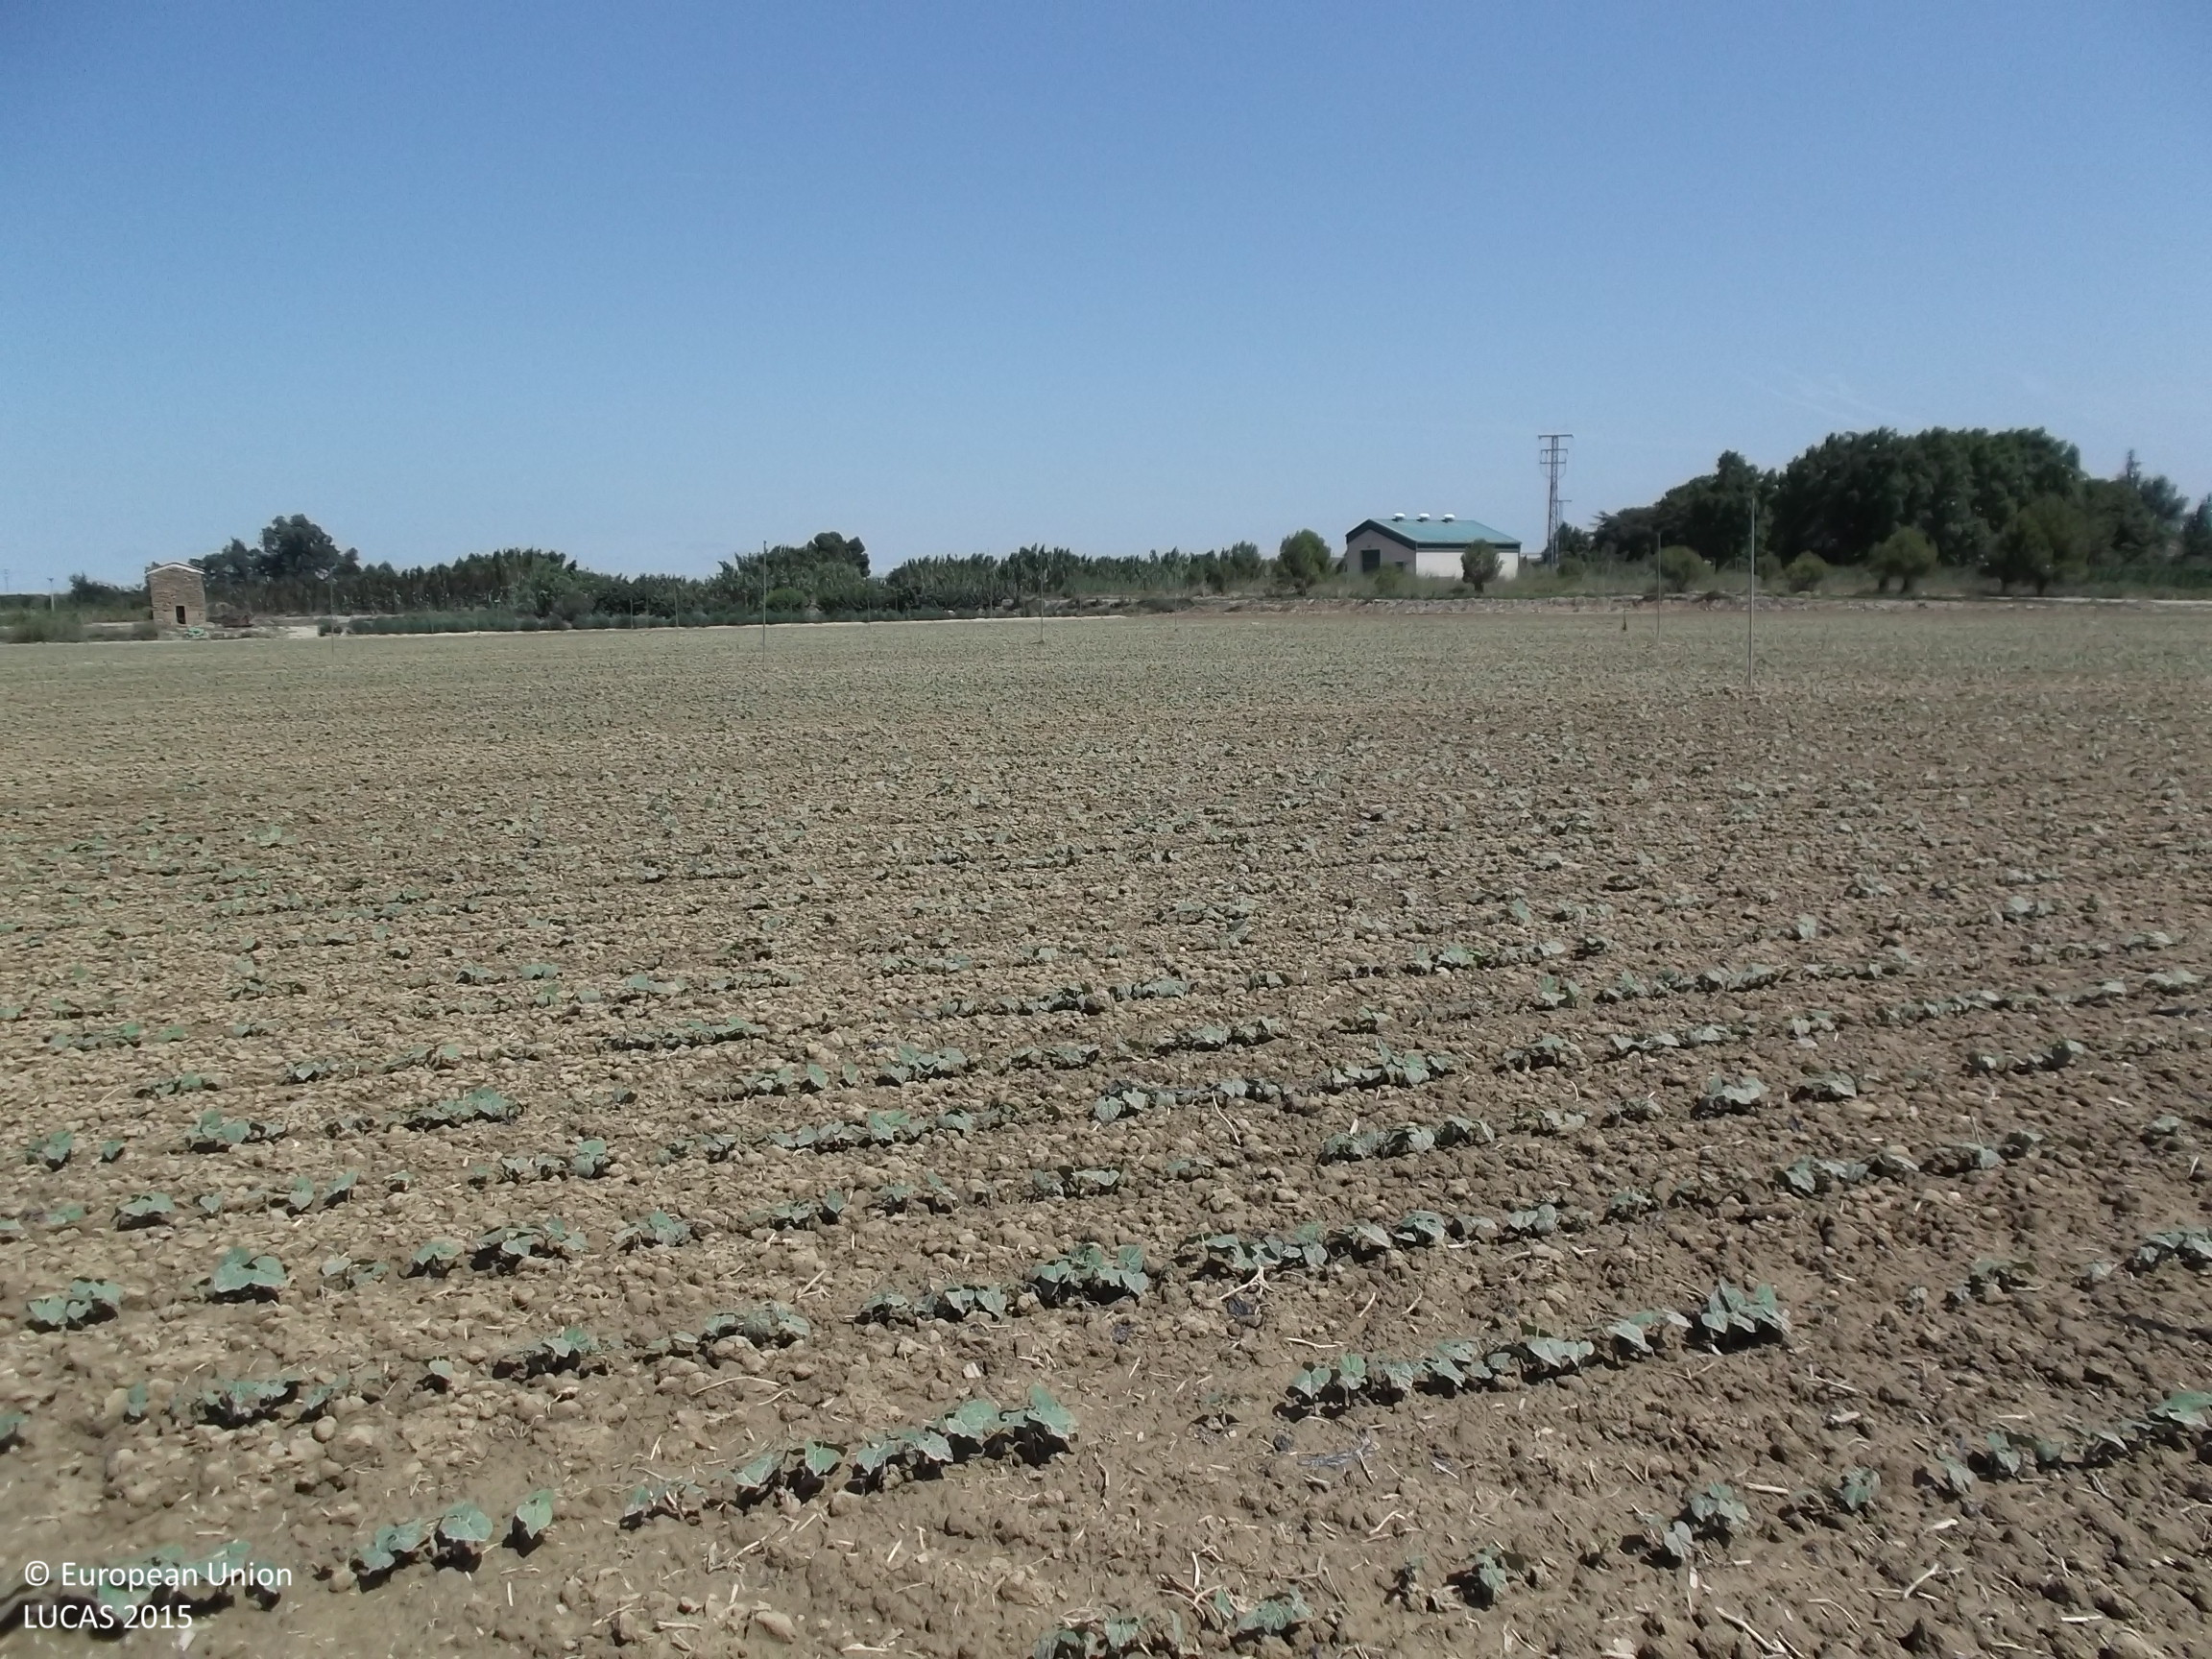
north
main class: Cropland
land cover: Dry pulses
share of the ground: < 10 %
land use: Agriculture (excluding fallow land and kitchen gardens)
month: July
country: ES
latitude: 42.3644
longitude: -1.6308
